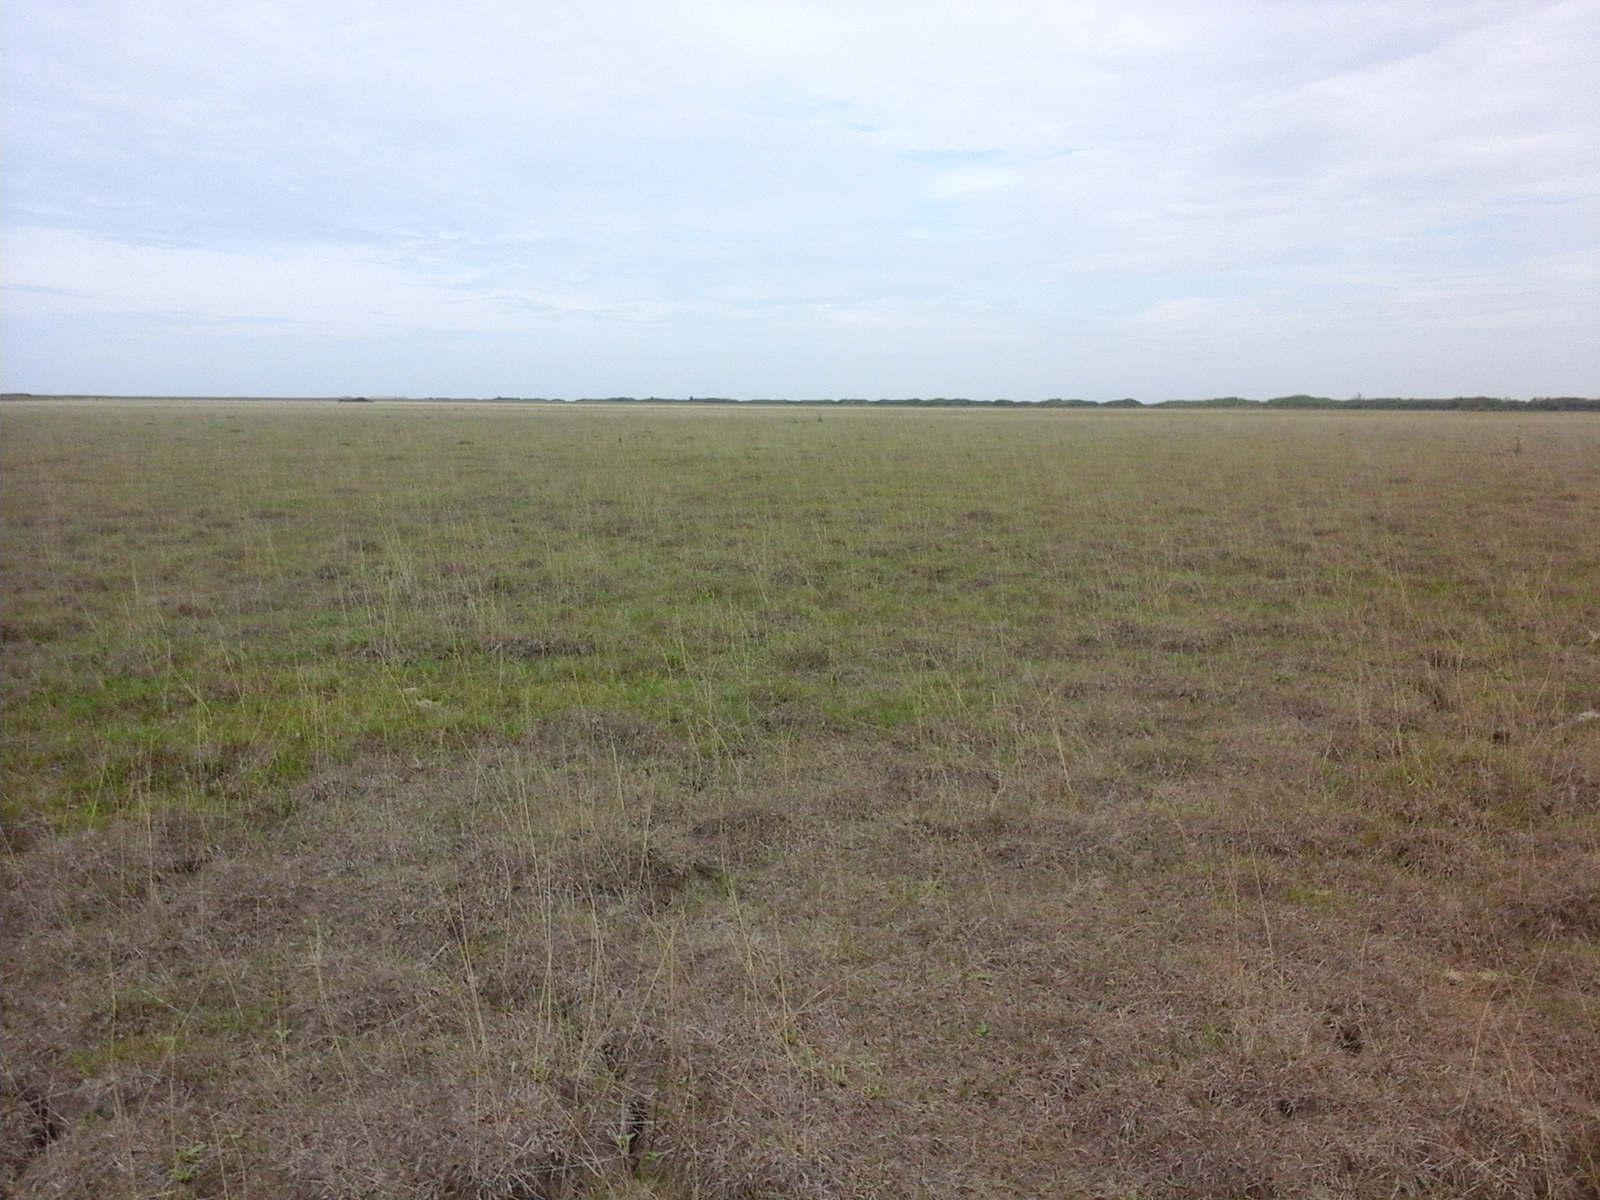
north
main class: Grassland
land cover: Grassland without tree/shrub cover
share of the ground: > 75 %
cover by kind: herbaceous plants 100 %
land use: Agriculture (excluding fallow land and kitchen gardens)
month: August
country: RO
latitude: 46.5374
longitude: 21.4202
